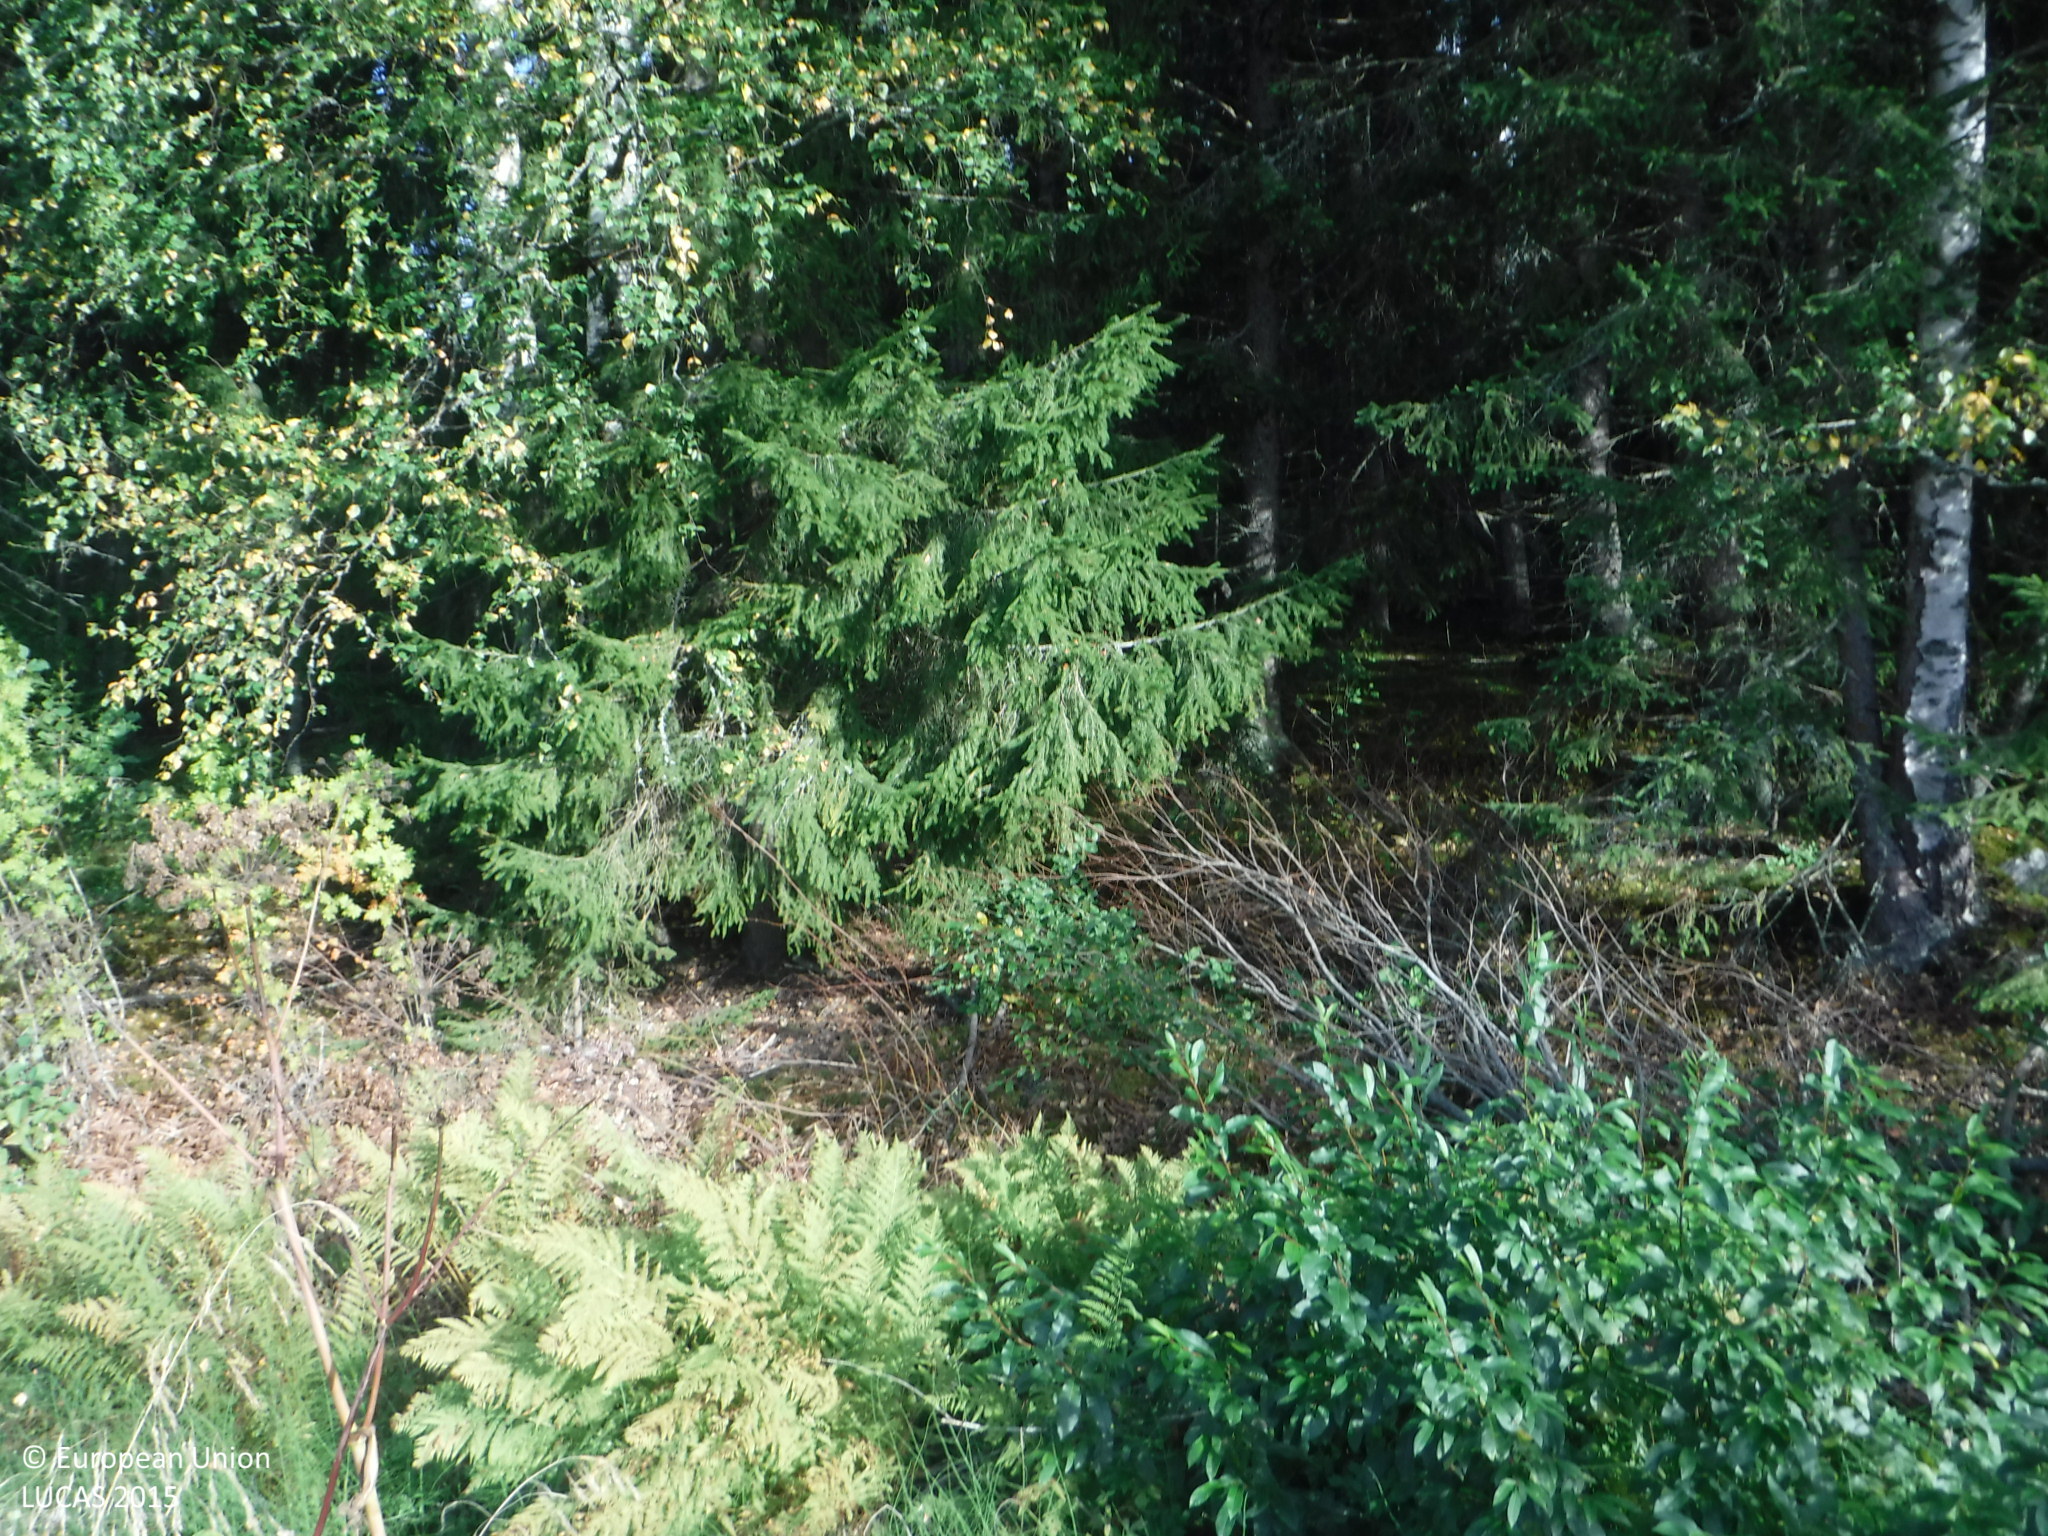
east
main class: Cropland
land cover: Oats
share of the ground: > 75 %
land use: Agriculture (excluding fallow land and kitchen gardens)
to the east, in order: Oats; Grass margins; Ditches and canals; Groves; Spruce dominated coniferous woodland; Shrubland with sparse tree cover; Spruce dominated coniferous woodland; Other mixed woodland; Tracks; Grass margins
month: September
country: FI
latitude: 61.4147
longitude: 23.0943
